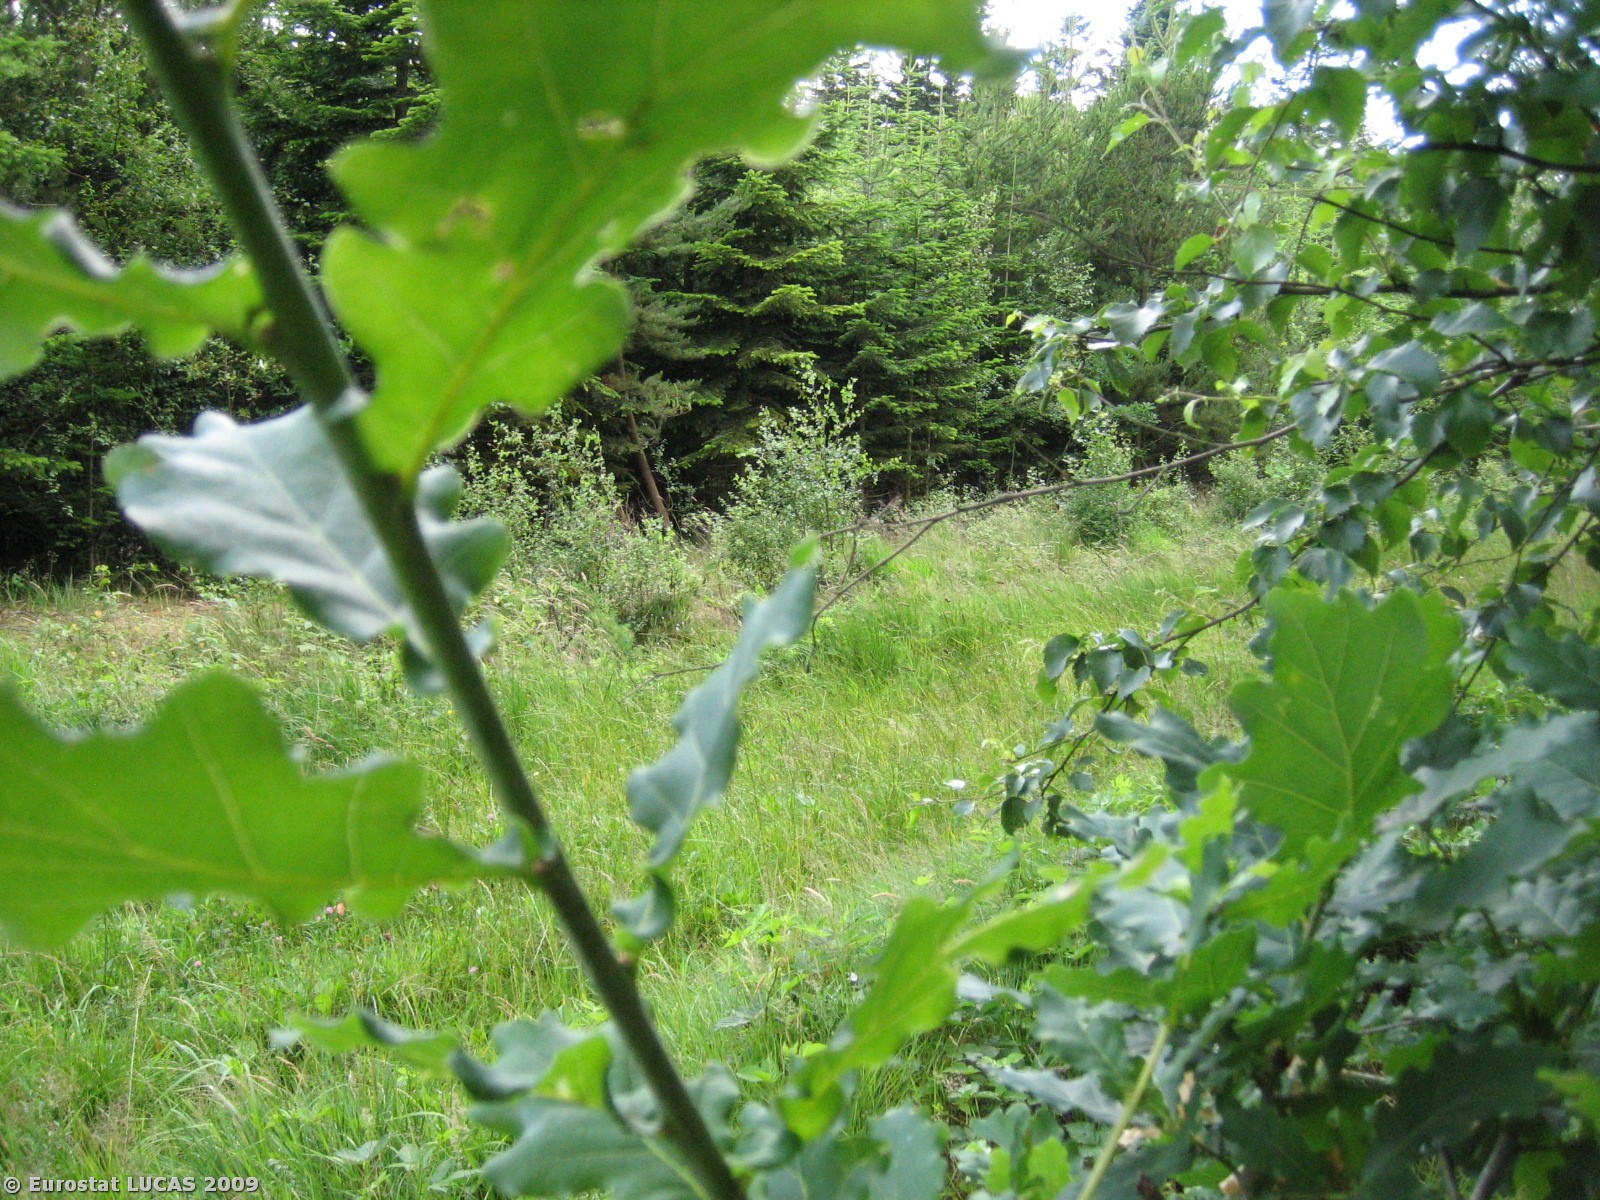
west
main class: Woodland
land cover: Mixed woodland
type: acidophilous oak and oak-birch forest
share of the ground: > 75 %
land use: Forestry
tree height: > 5 m
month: July
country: DK
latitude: 55.5489
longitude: 8.4322
